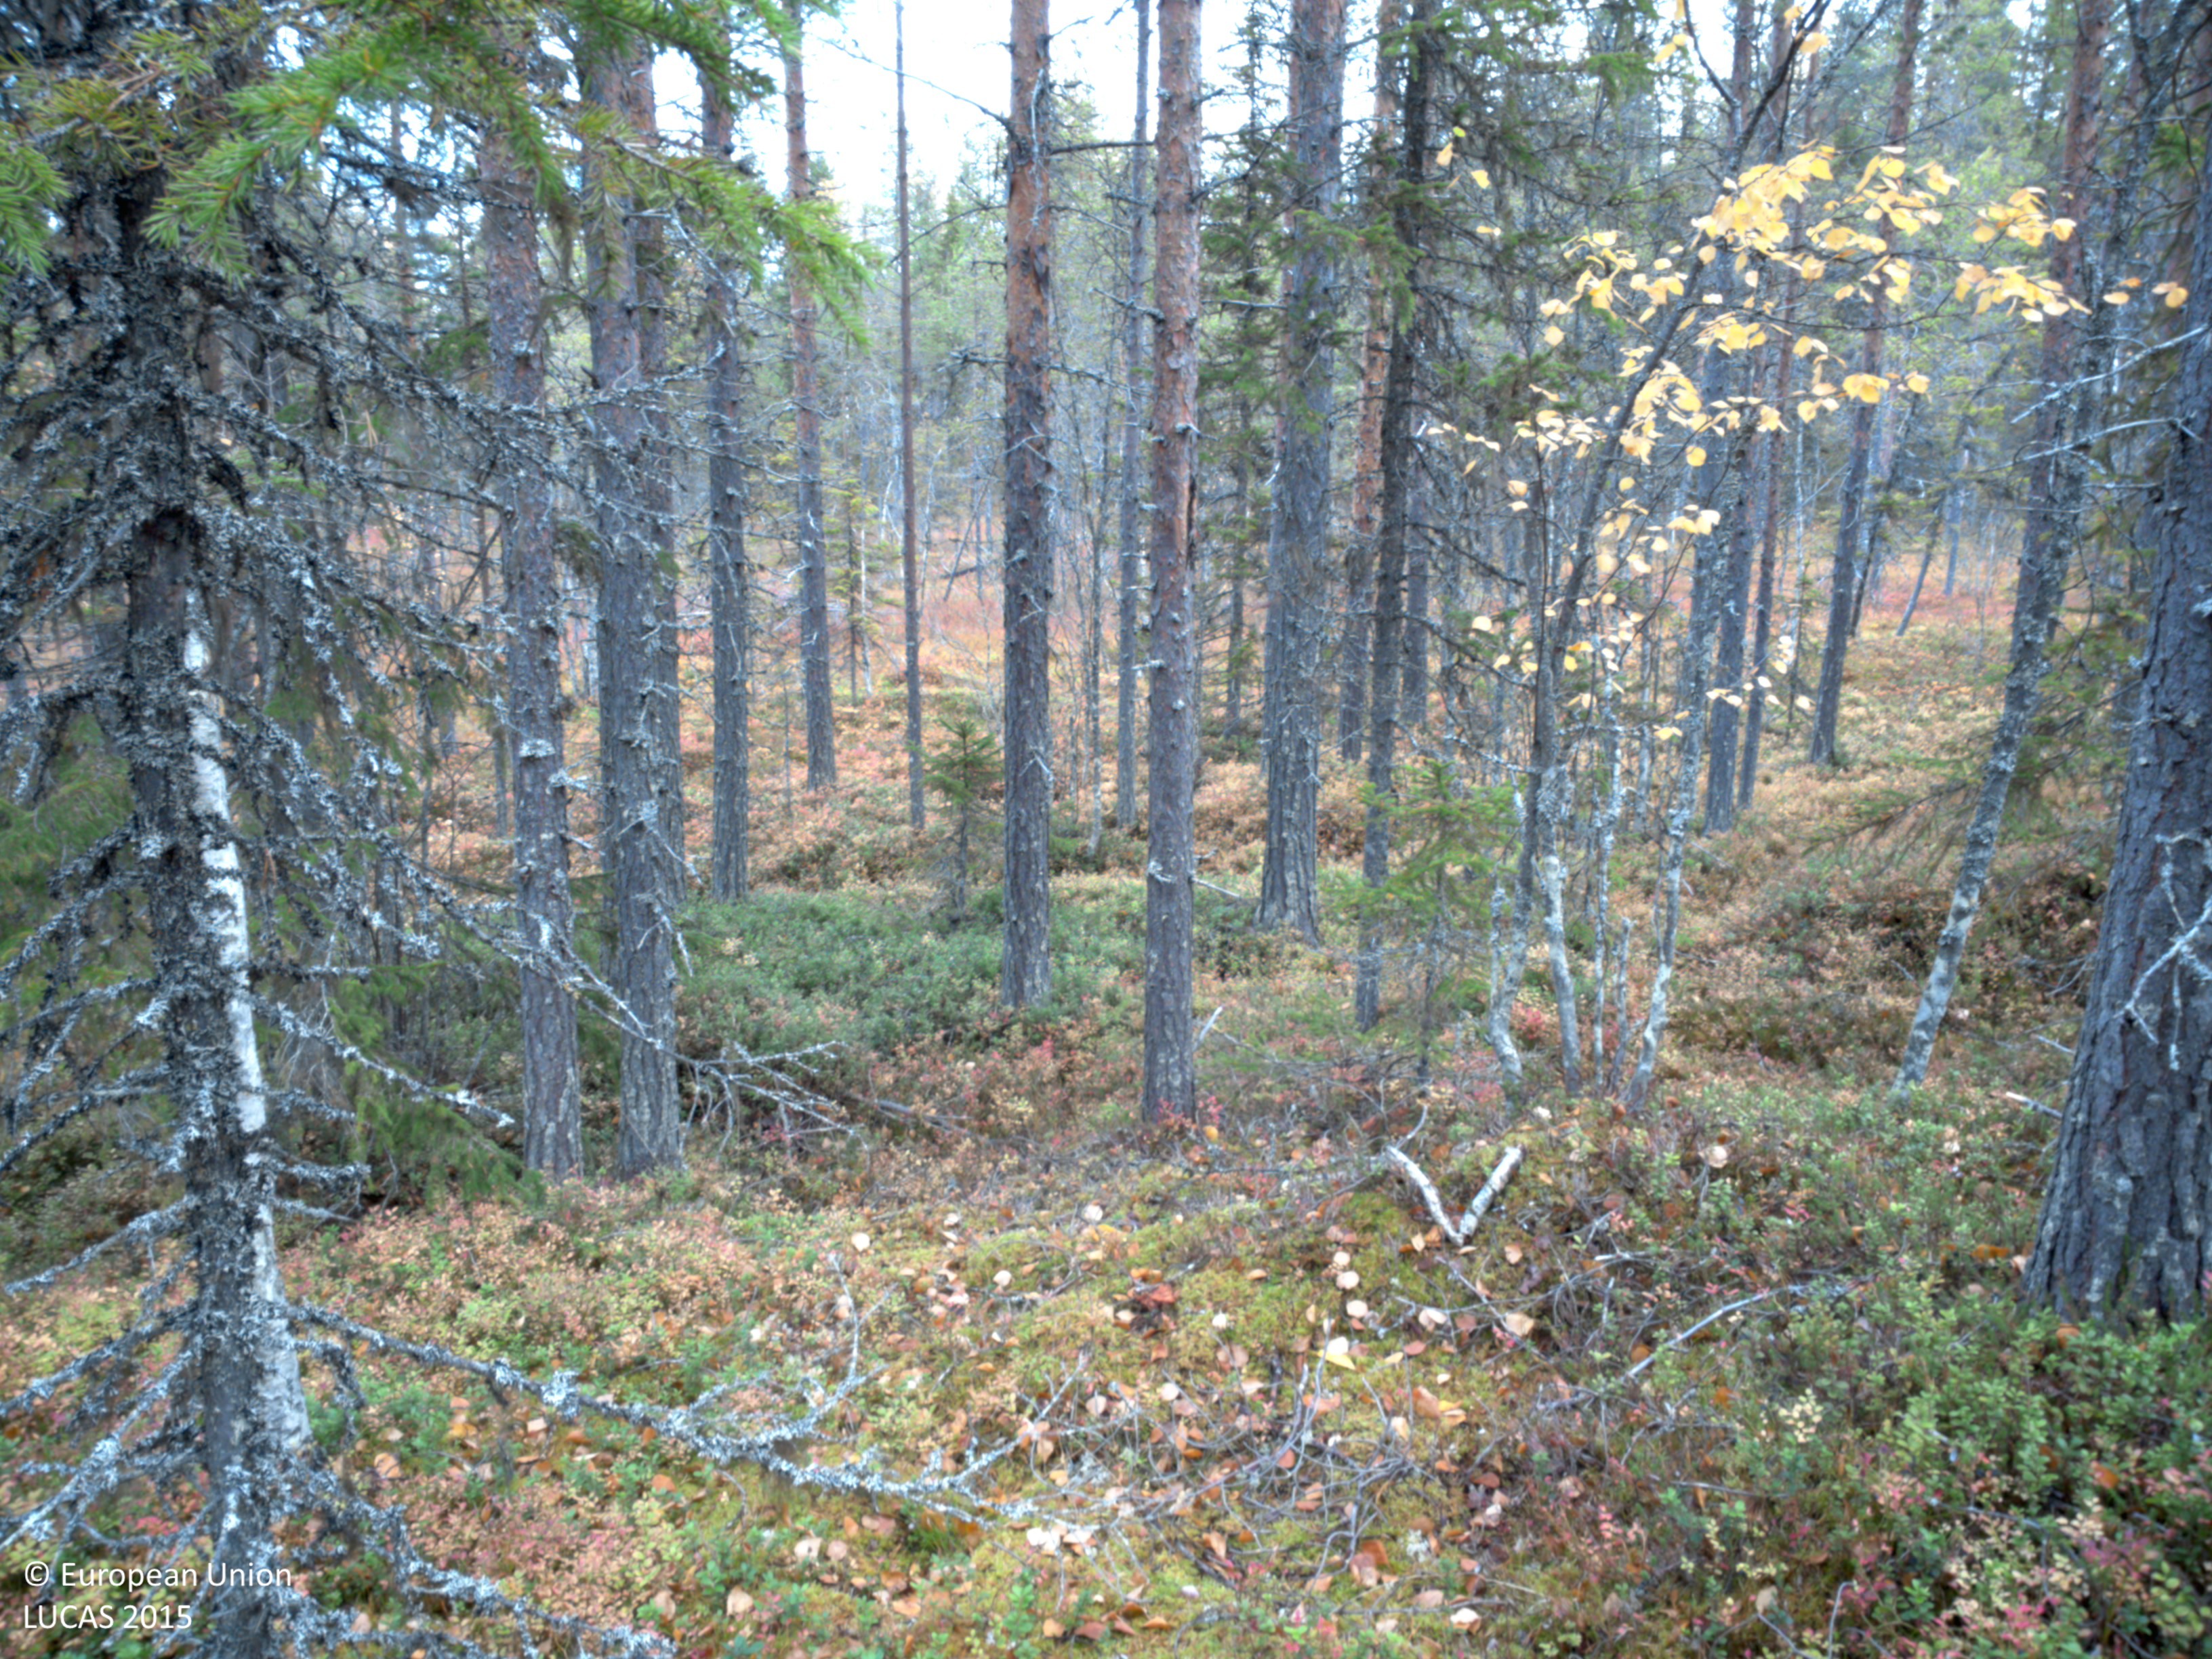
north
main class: Woodland
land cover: Other coniferous woodland
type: boreal forest
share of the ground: 50 - 75 %
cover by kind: coniferous forest trees 65 %, shrubs 20 %, broadleaved forest trees 5 %, herbaceous plants 5 %, lichens and mosses 5 %
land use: Forestry
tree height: > 5 m
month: October
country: SE
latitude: 64.9819
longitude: 17.9109
